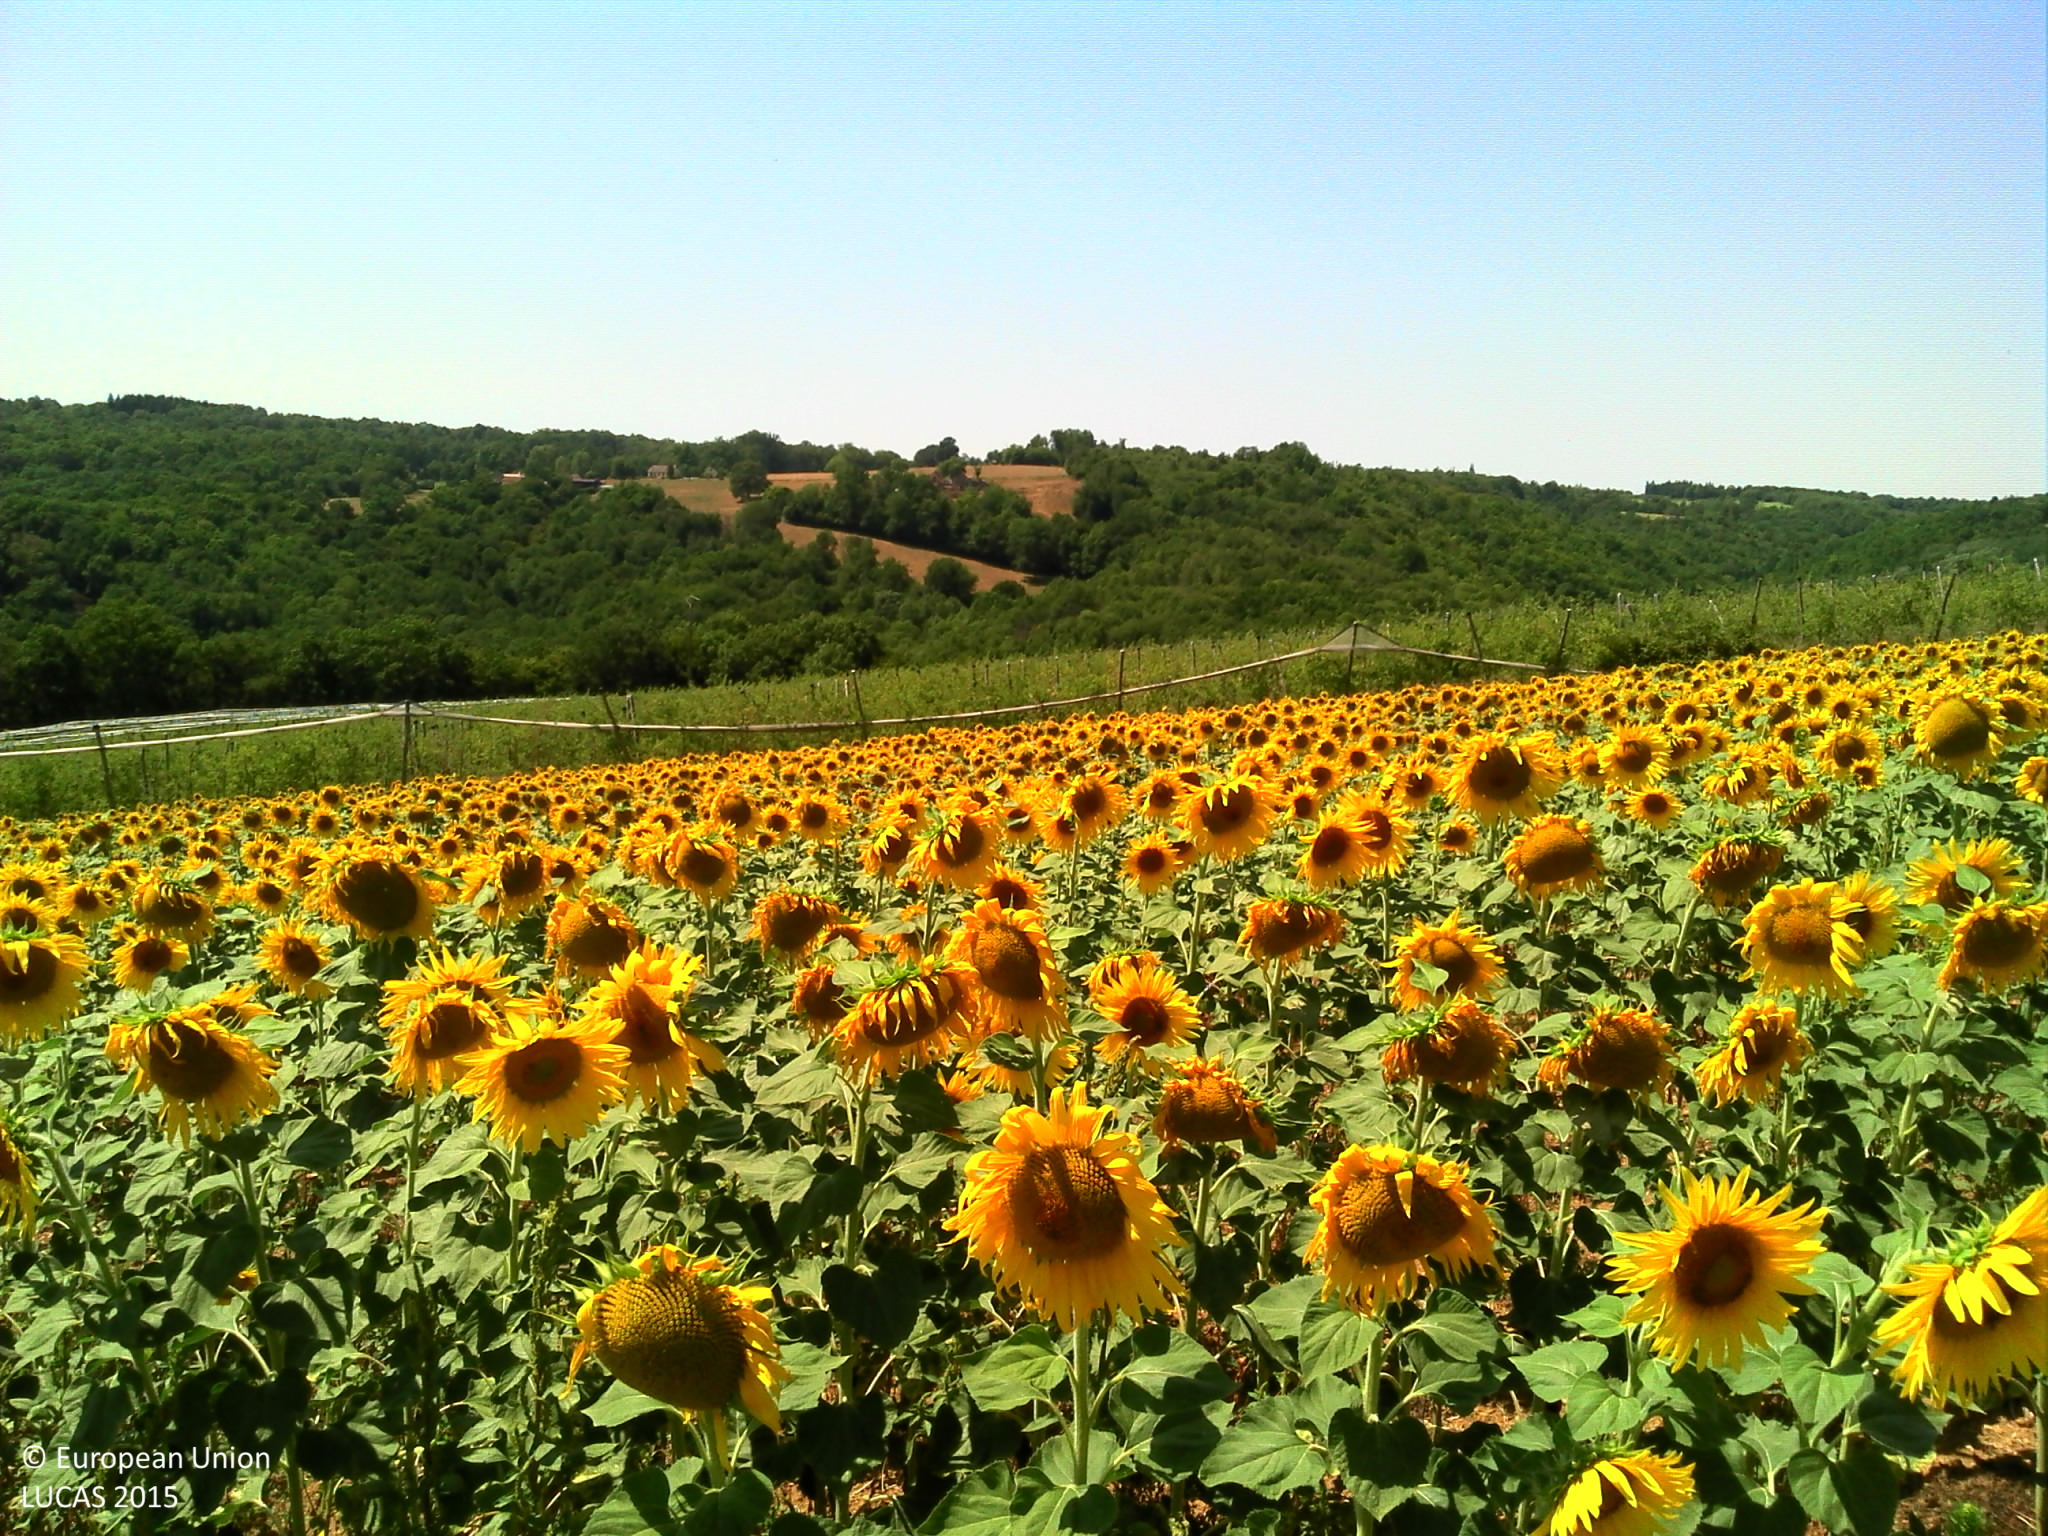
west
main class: Cropland
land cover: Sunflower
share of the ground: 50 - 75 %
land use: Agriculture (excluding fallow land and kitchen gardens)
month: August
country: FR
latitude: 45.3630
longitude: 1.0934
